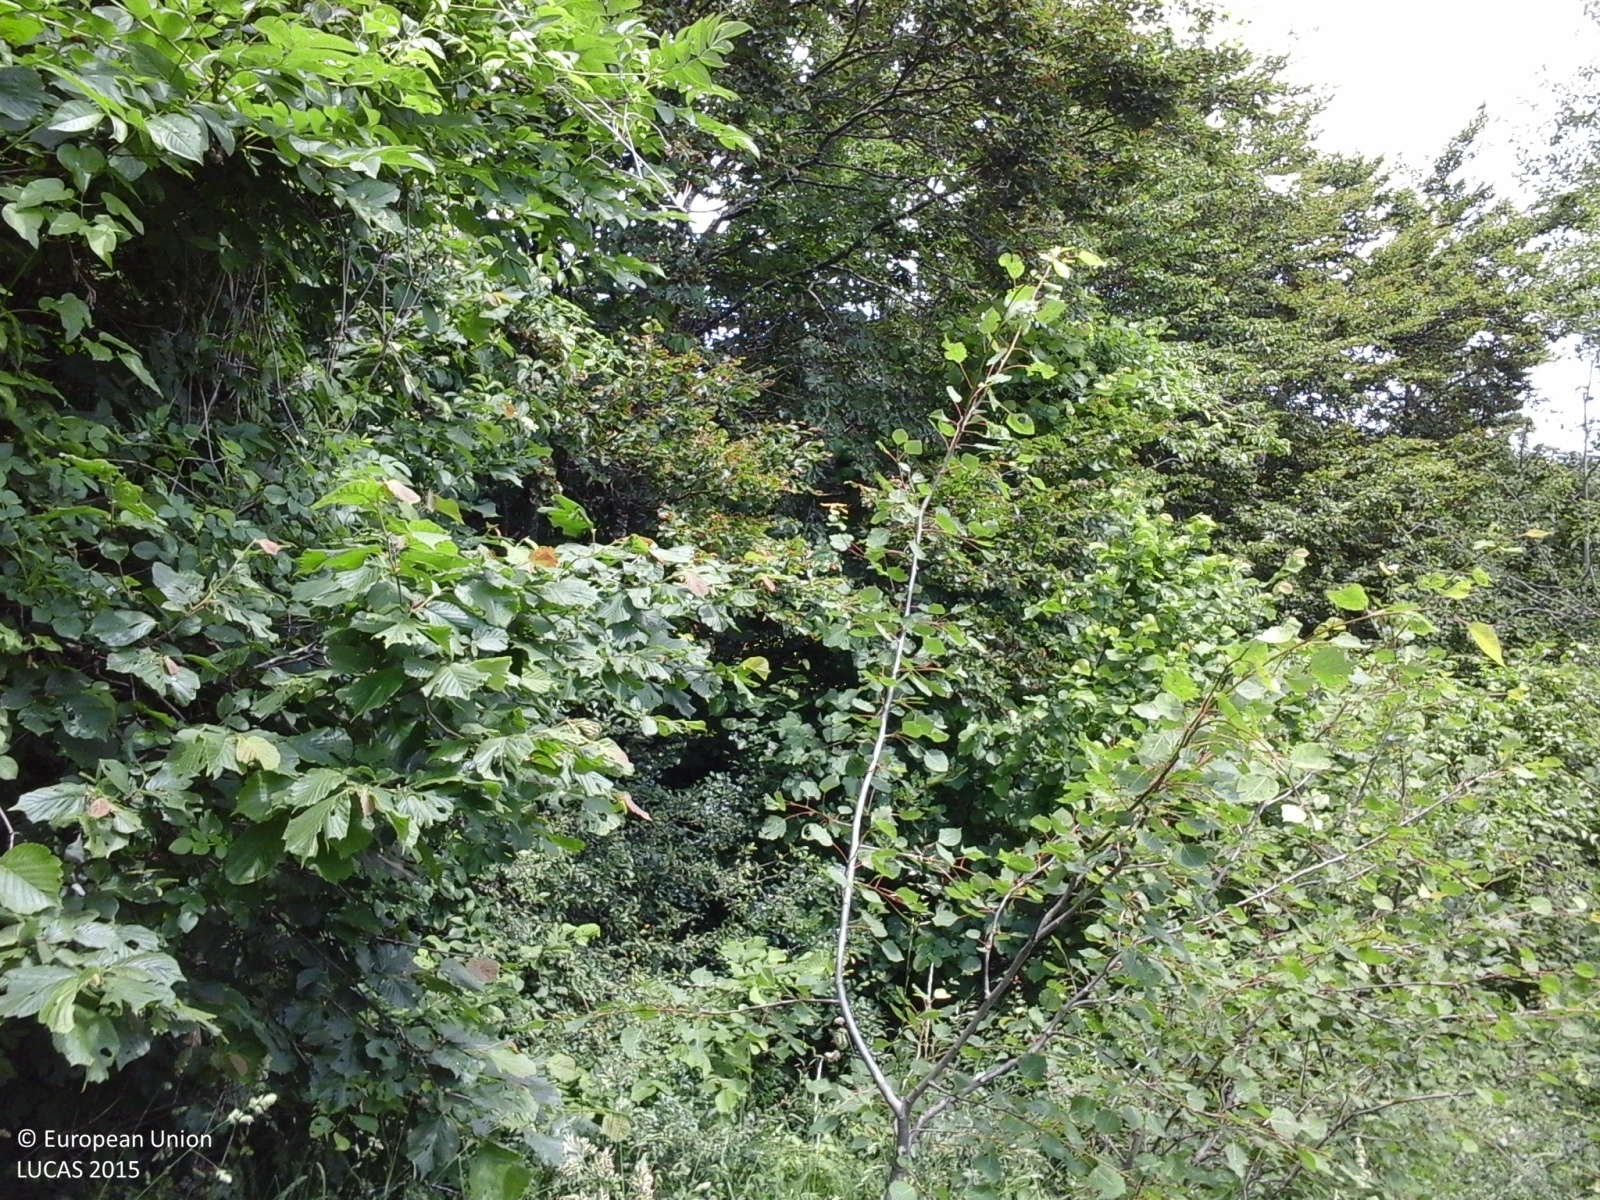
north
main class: Grassland
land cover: Grassland without tree/shrub cover
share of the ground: > 75 %
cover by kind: herbaceous plants 100 %
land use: Forestry
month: June
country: IT
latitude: 44.6927
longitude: 9.6852
